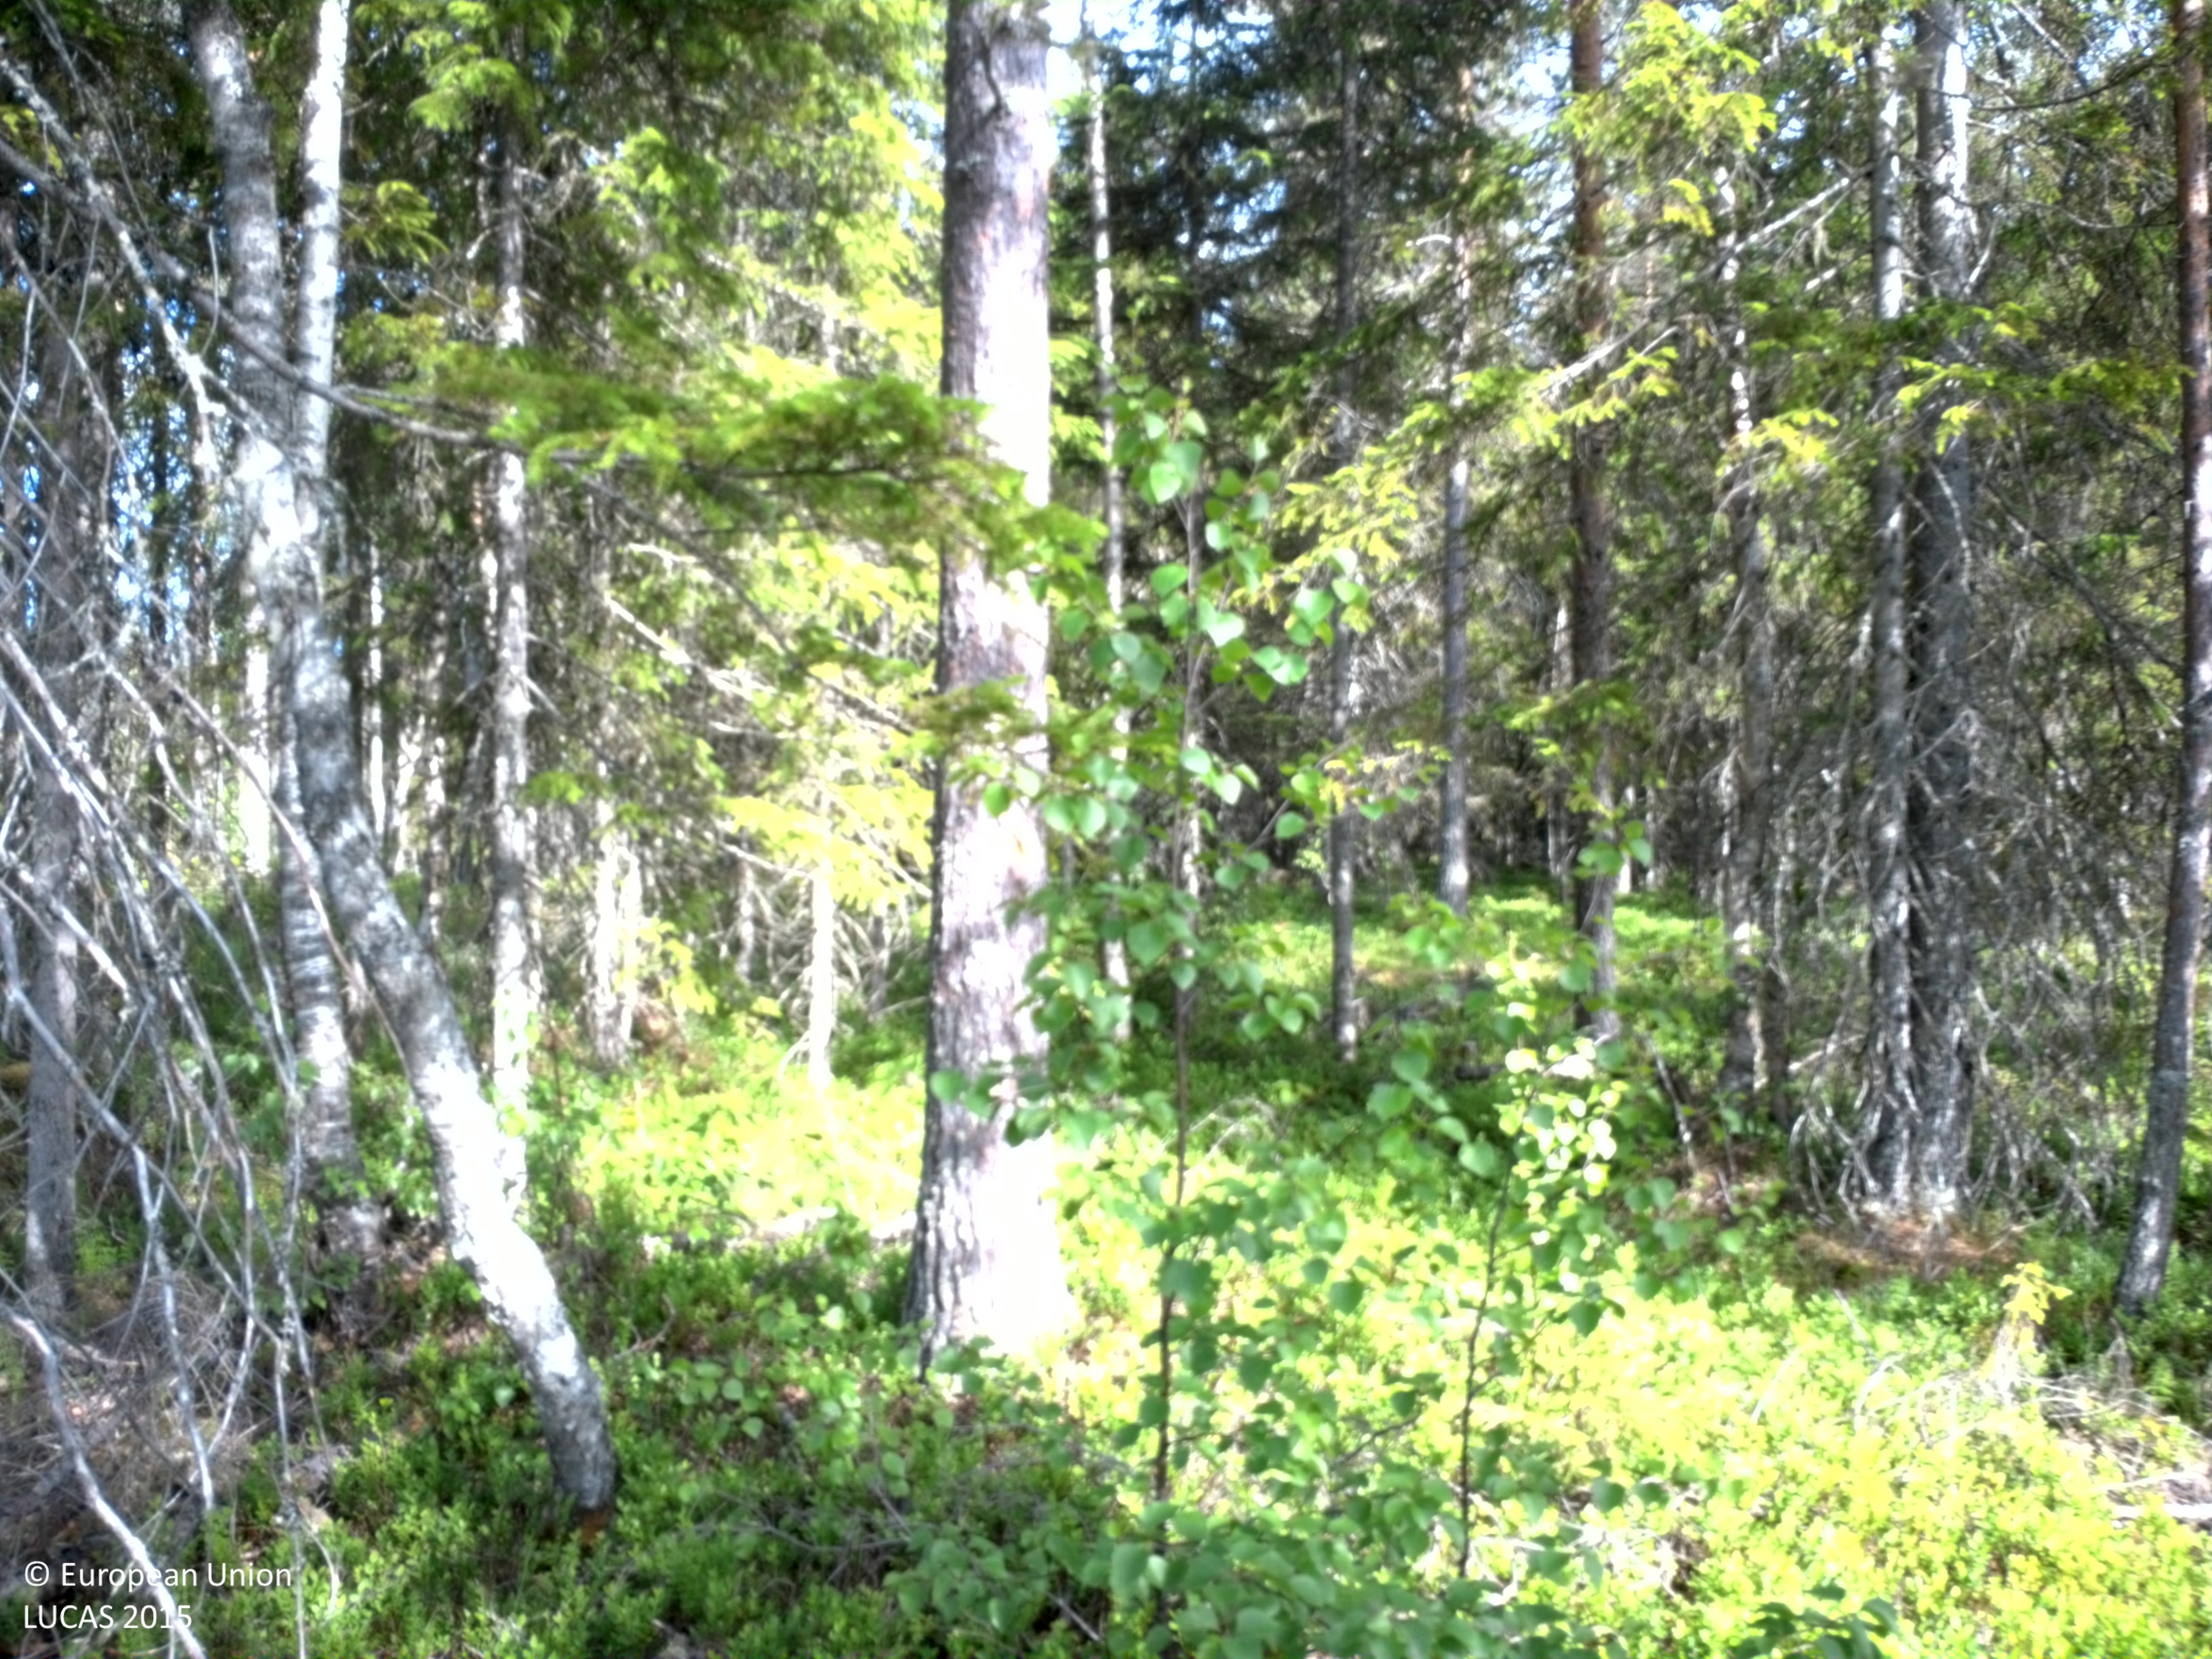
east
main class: Woodland
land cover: Other mixed woodland
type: boreal forest
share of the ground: 50 - 75 %
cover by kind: coniferous forest trees 45 %, shrubs 25 %, broadleaved forest trees 20 %, herbaceous plants 10 %
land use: Forestry
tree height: > 5 m
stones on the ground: < 10 %
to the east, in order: Other mixed woodland; Spruce dominated coniferous woodland; Ditches and canals; Spruce dominated mixed woodland; Broadleaved woodland; Spruce dominated mixed woodland
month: July
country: SE
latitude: 64.3526
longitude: 20.6020
